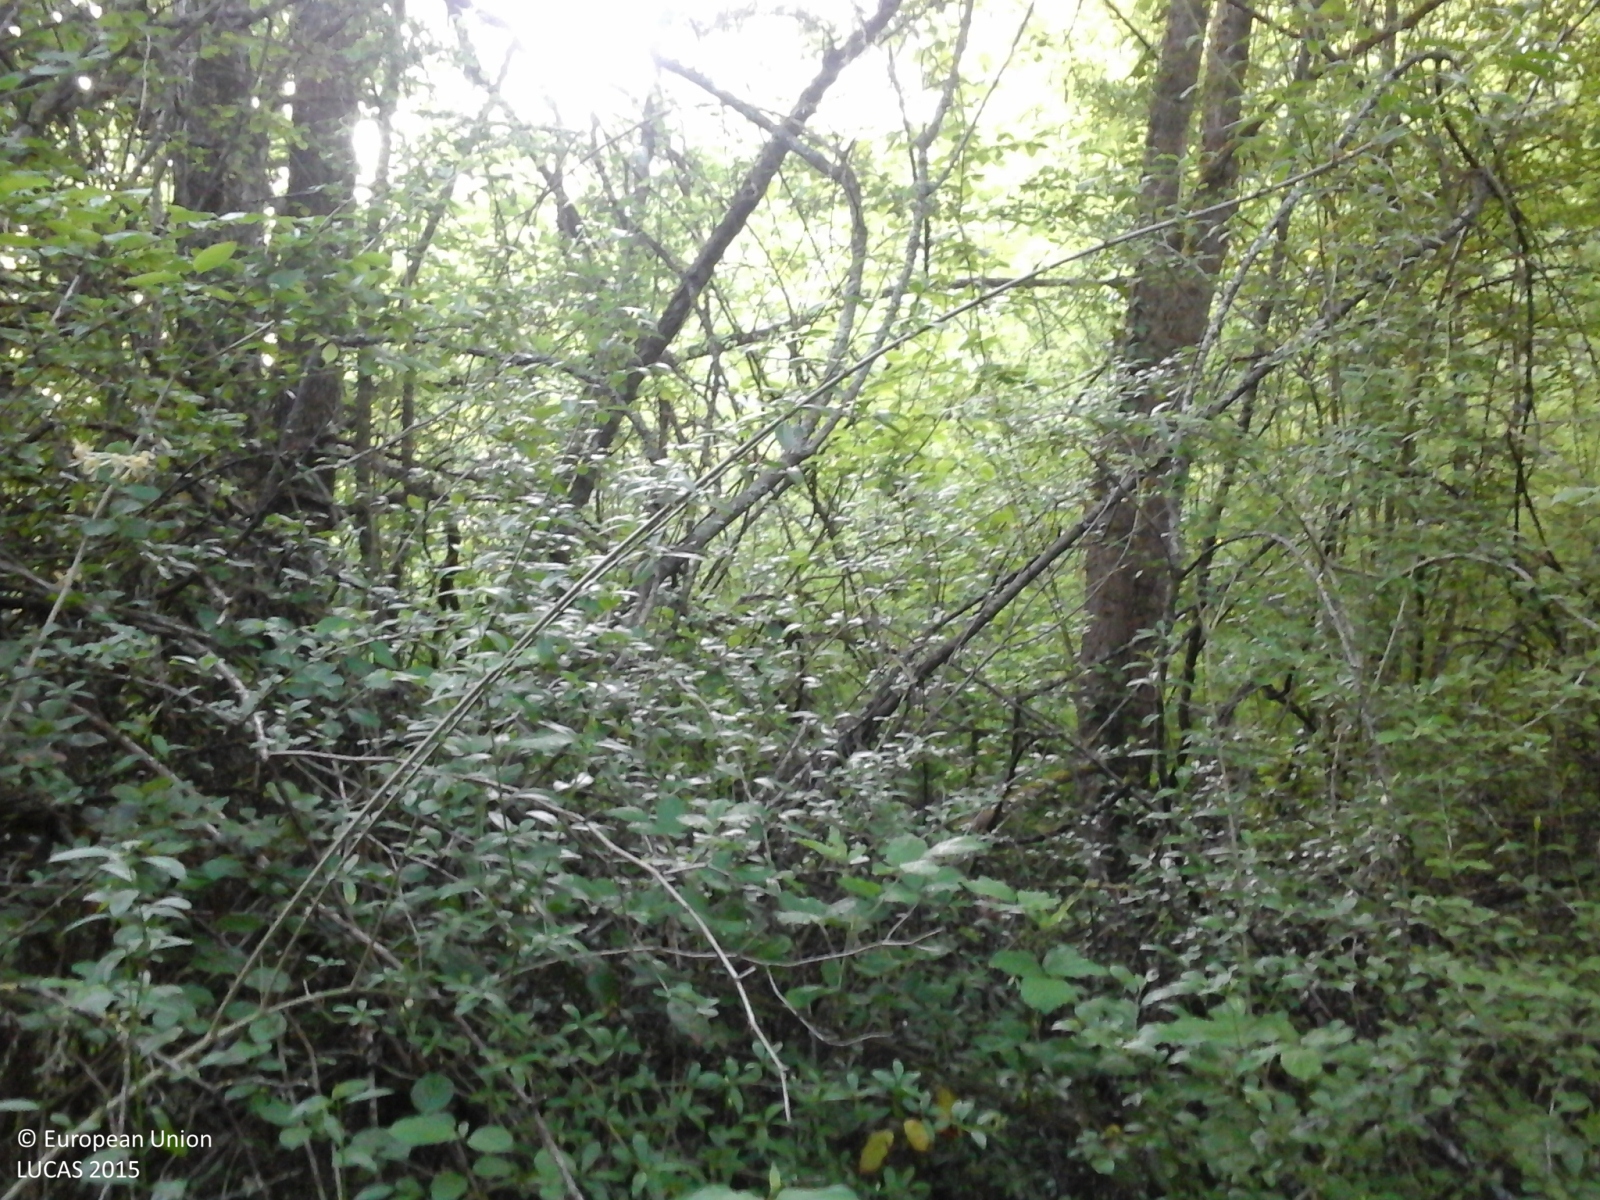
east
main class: Woodland
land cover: Broadleaved woodland
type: thermophilous deciduous forest
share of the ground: > 75 %
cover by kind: broadleaved forest trees 70 %, shrubs 30 %
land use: Forestry
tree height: > 5 m
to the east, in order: Broadleaved woodland; Other bare soil; Grass margins; Paved roads, cycling and walking lanes; Broadleaved woodland; Grassland without tree/shrub cover
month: May
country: IT
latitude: 44.5845
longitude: 9.6858
